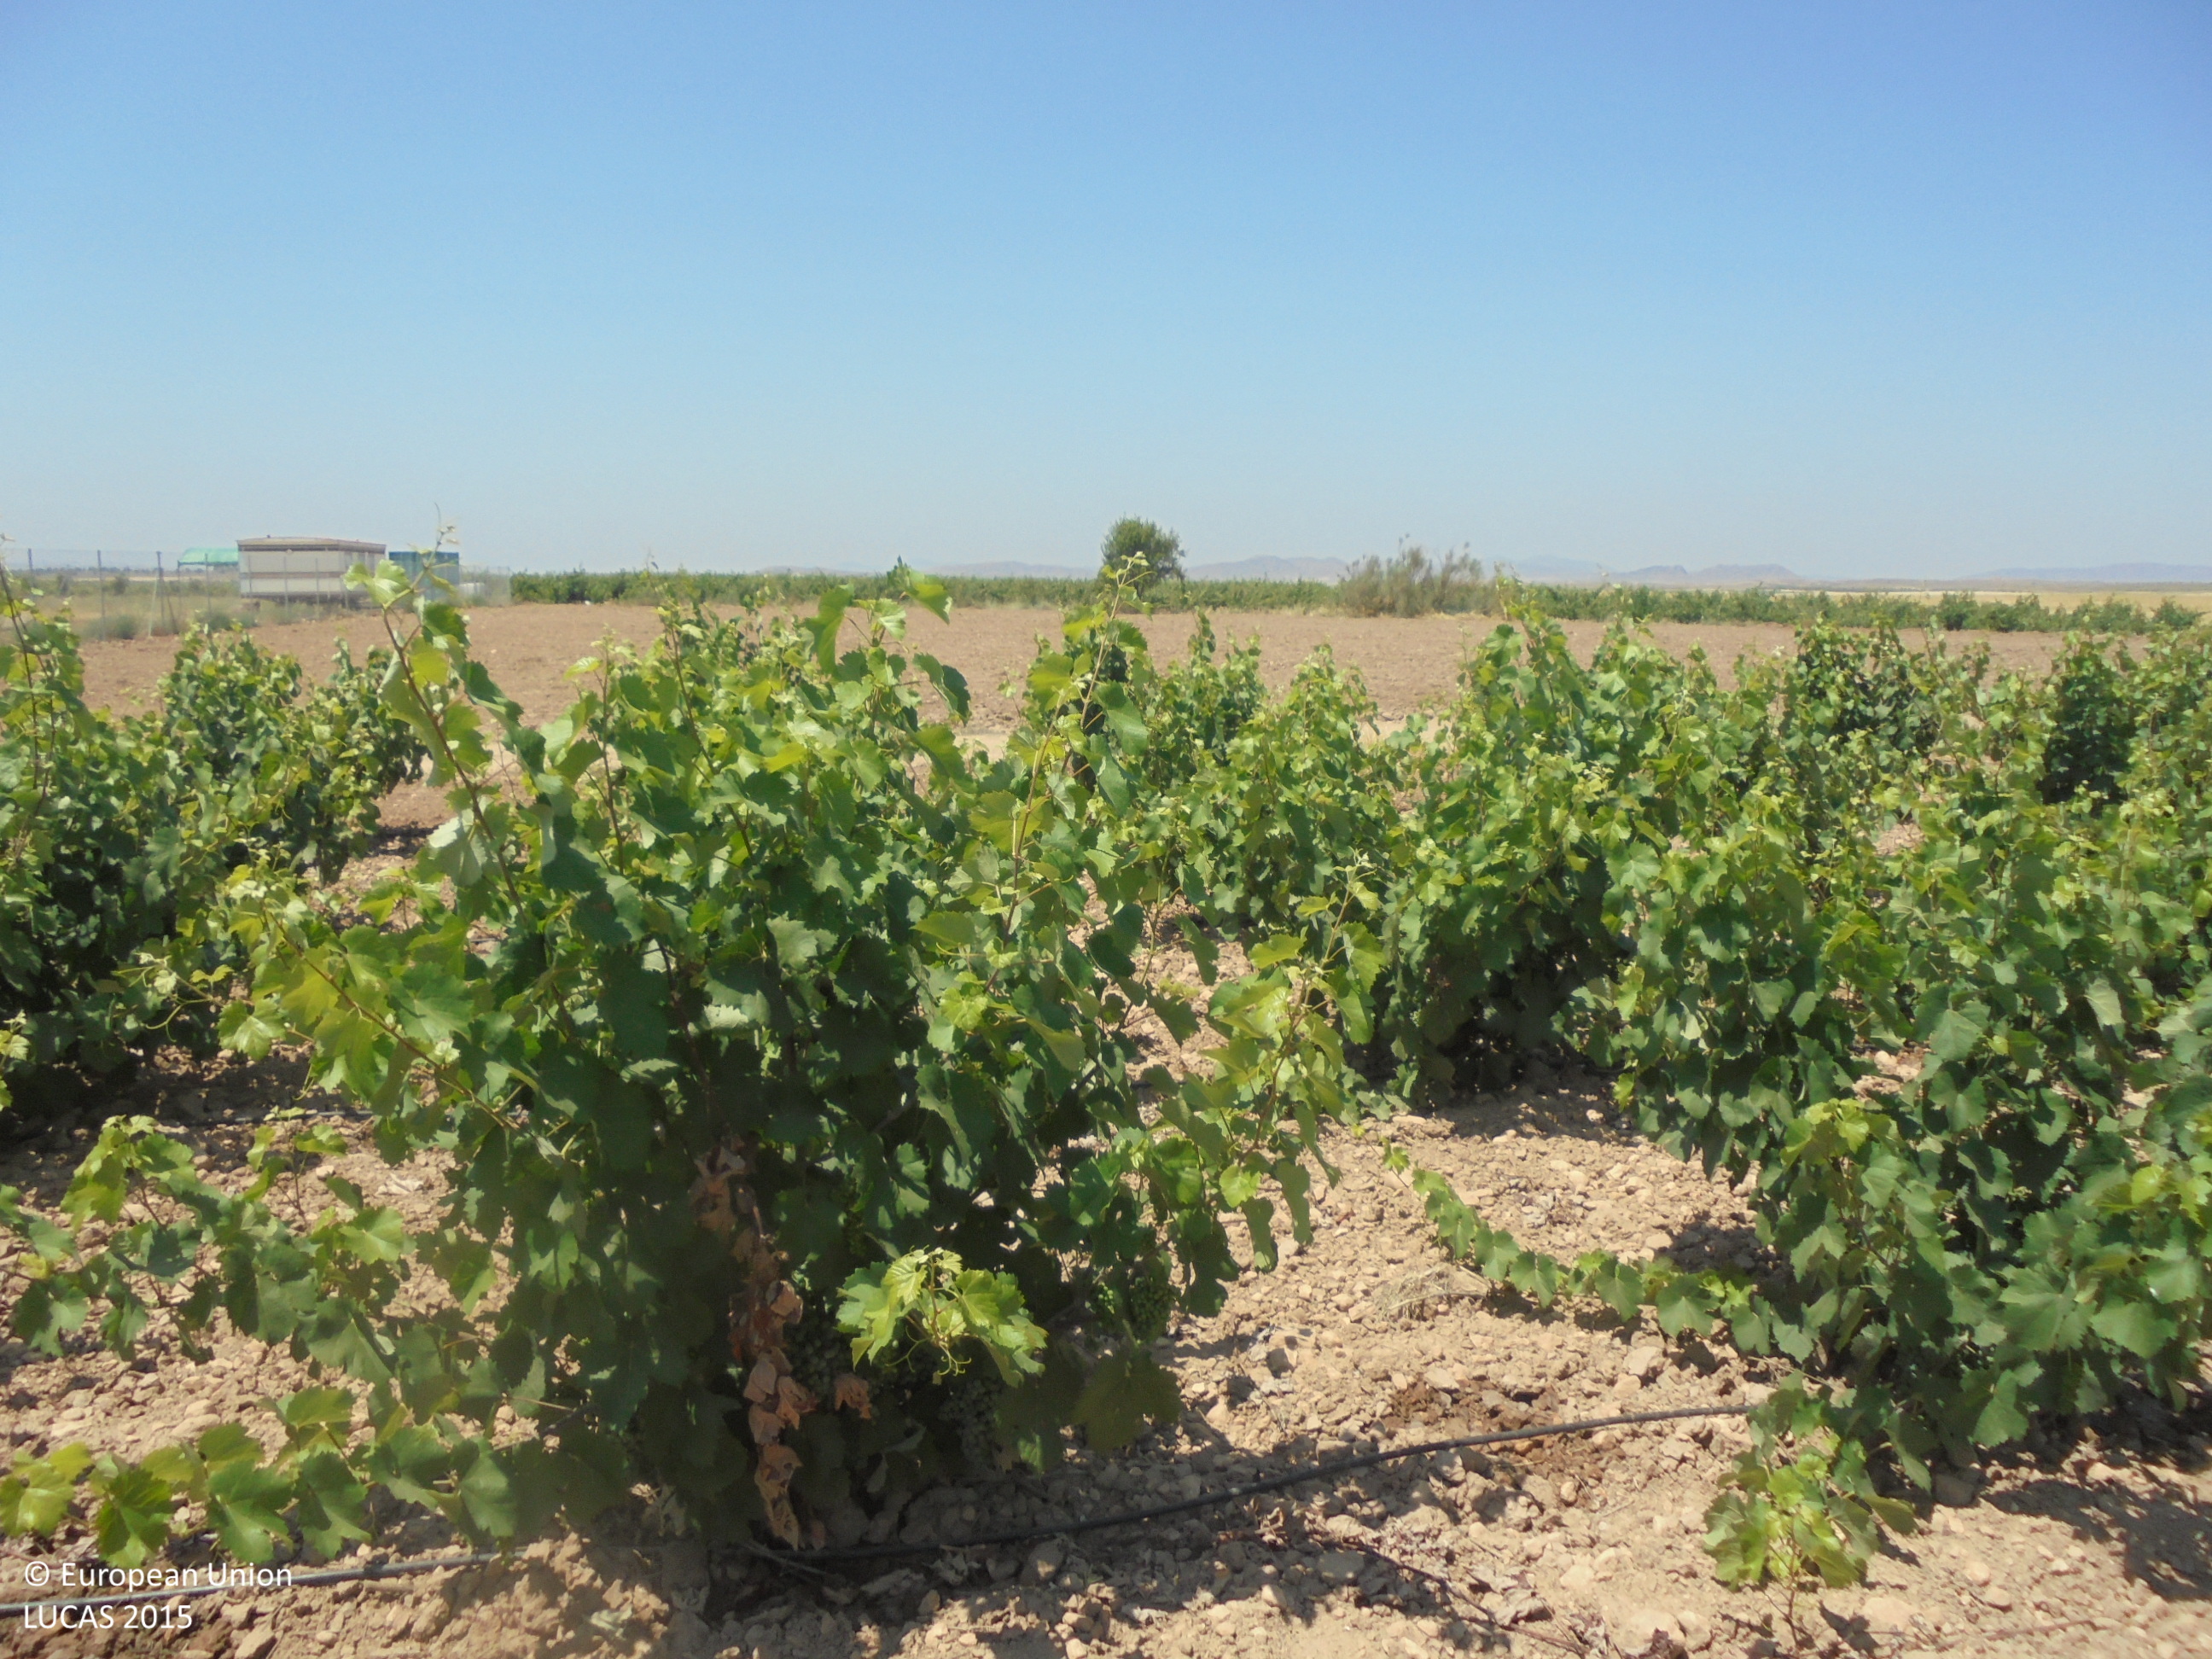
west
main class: Cropland
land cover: Vineyards
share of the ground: 25 - 50 %
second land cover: Other bare soil
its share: > 75 %
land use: Agriculture (excluding fallow land and kitchen gardens)
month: July
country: ES
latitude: 38.5445
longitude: -1.5235
